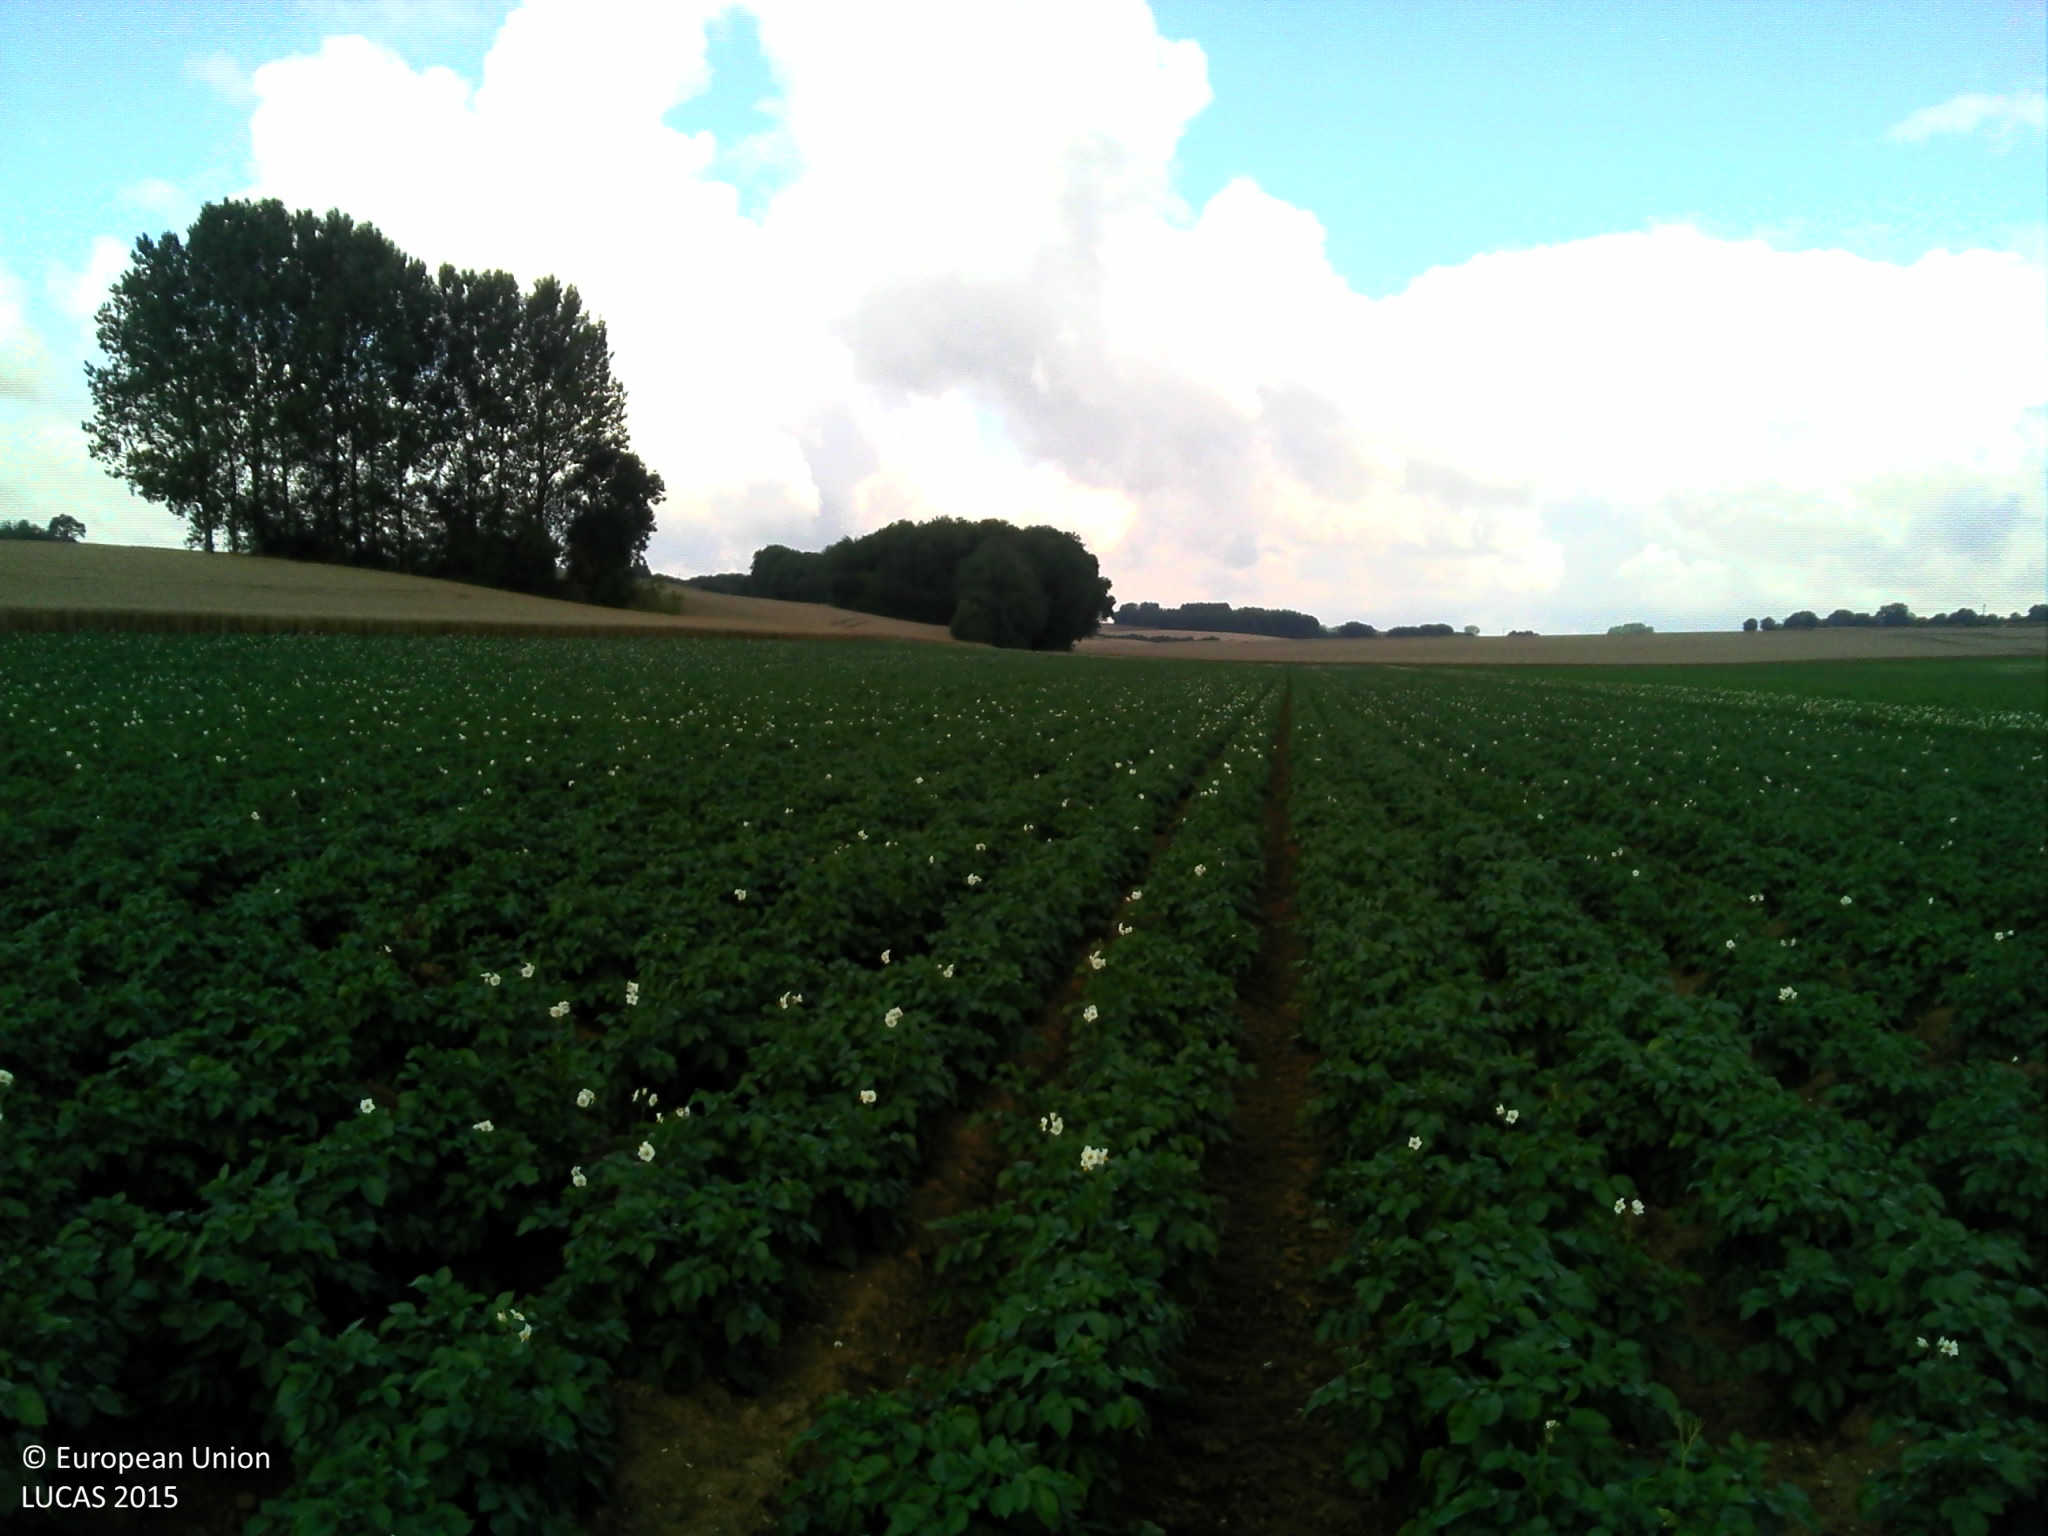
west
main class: Cropland
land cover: Potatoes
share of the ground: > 75 %
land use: Agriculture (excluding fallow land and kitchen gardens)
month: July
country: FR
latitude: 50.0410
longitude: 2.4332
